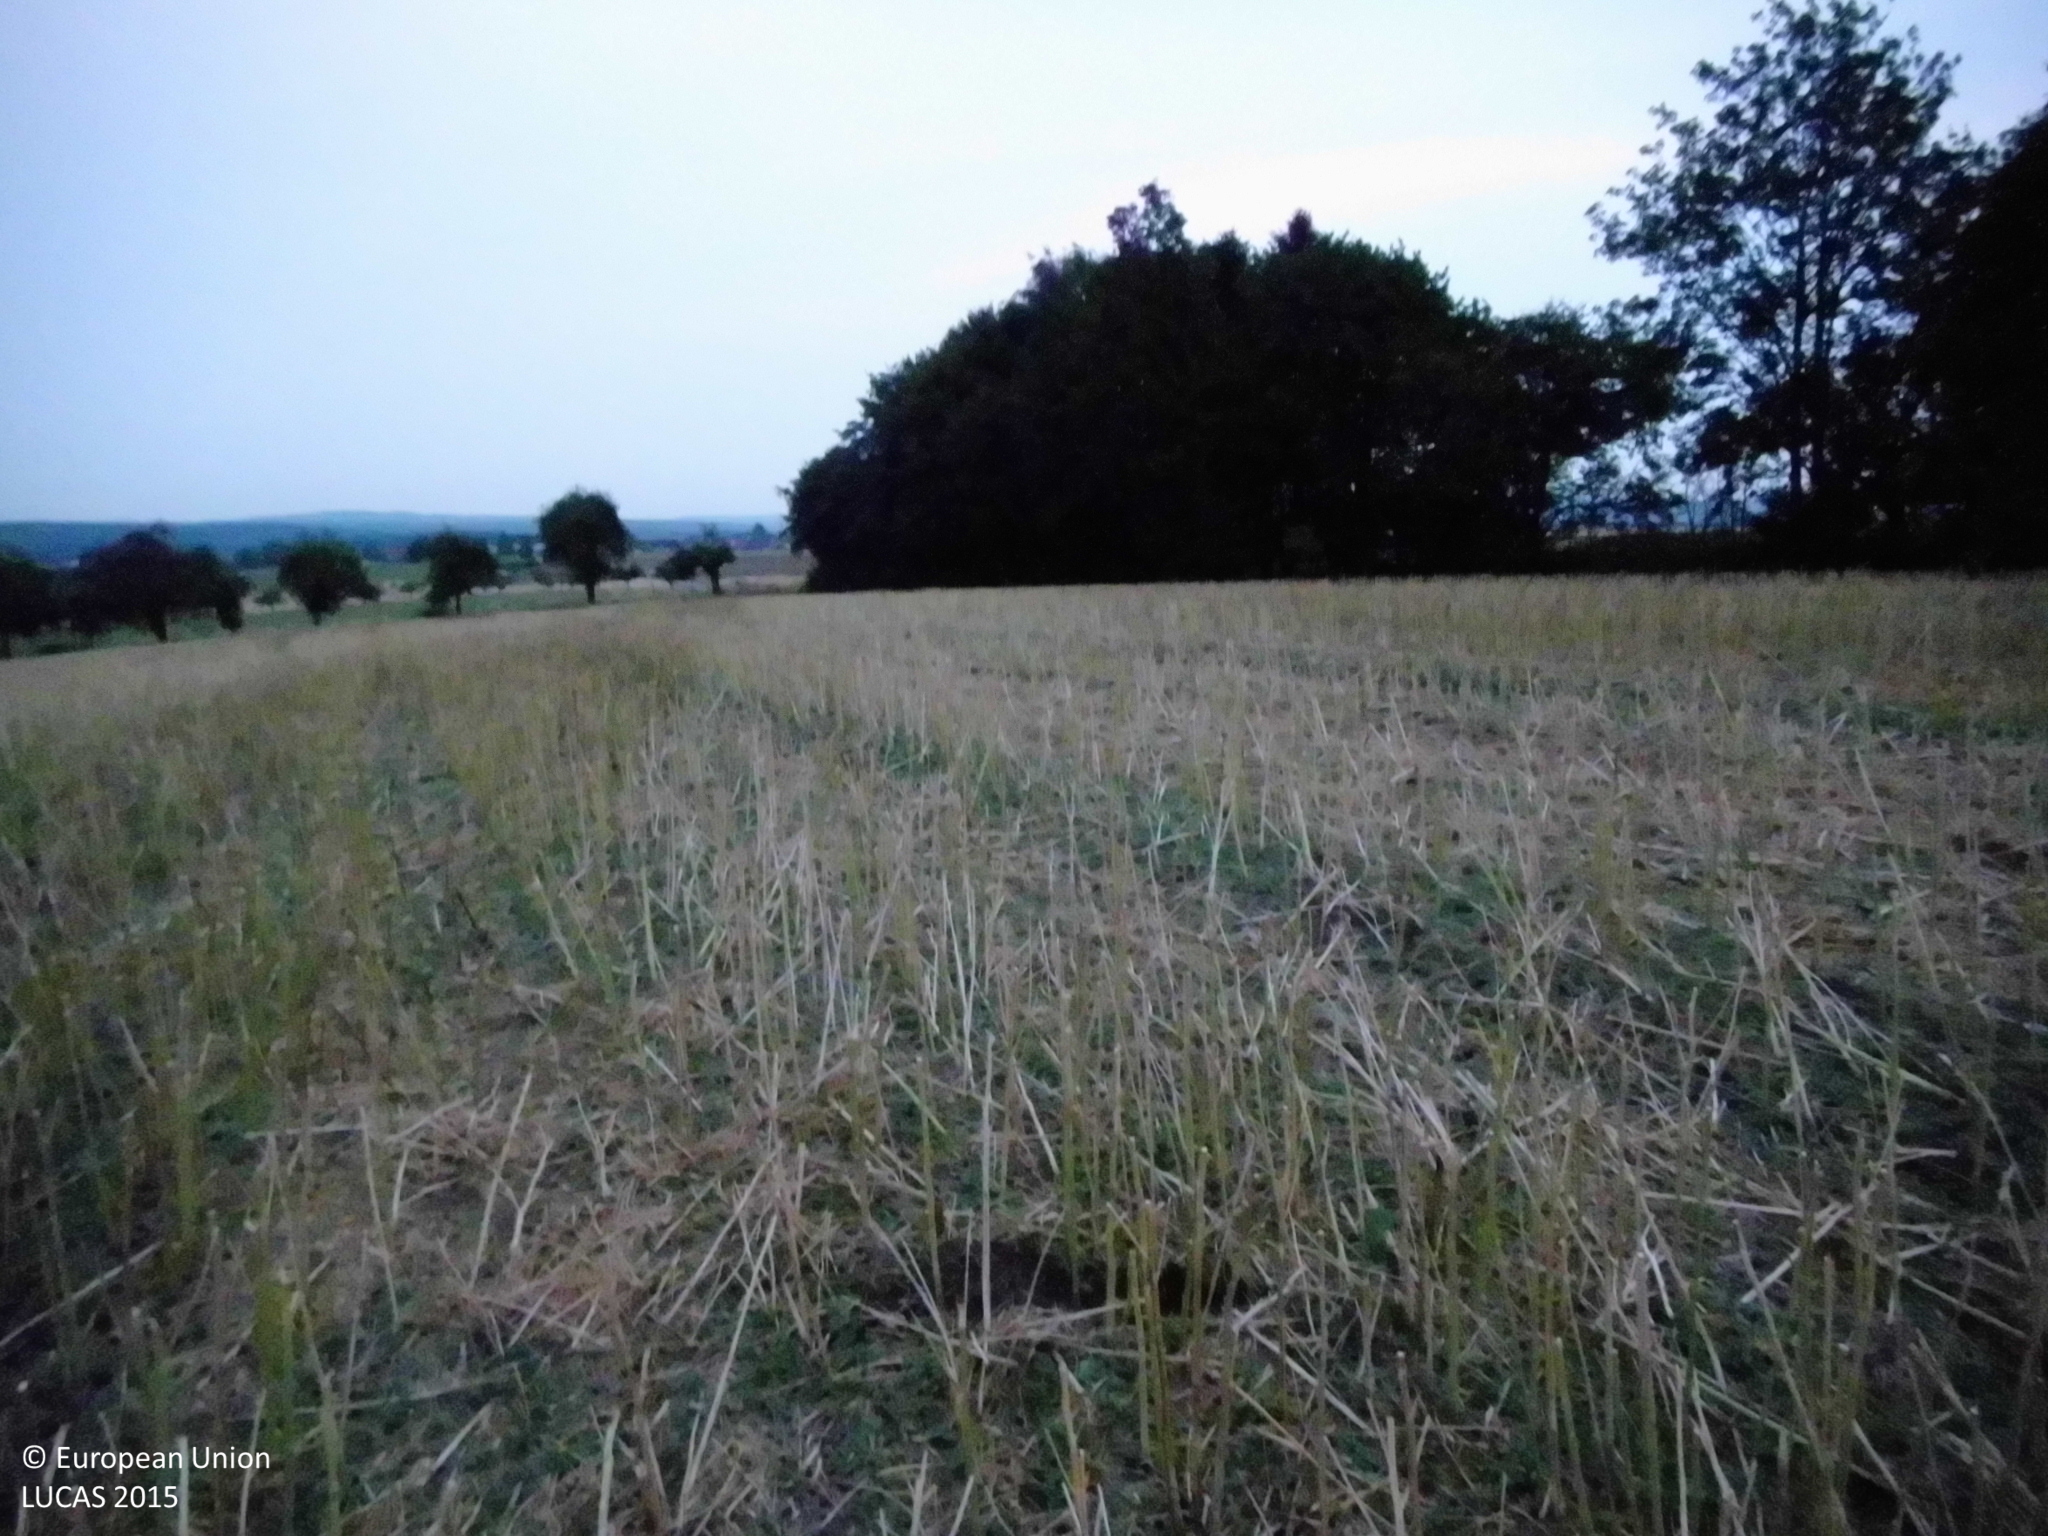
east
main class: Cropland
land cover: Rape and turnip rape
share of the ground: > 75 %
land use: Agriculture (excluding fallow land and kitchen gardens)
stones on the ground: < 10 %
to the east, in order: Rape and turnip rape; Grassland without tree/shrub cover; Paved roads, cycling and walking lanes; Broadleaved woodland; Grassland without tree/shrub cover; Common wheat
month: August
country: DE
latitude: 50.5354
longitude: 8.6036
